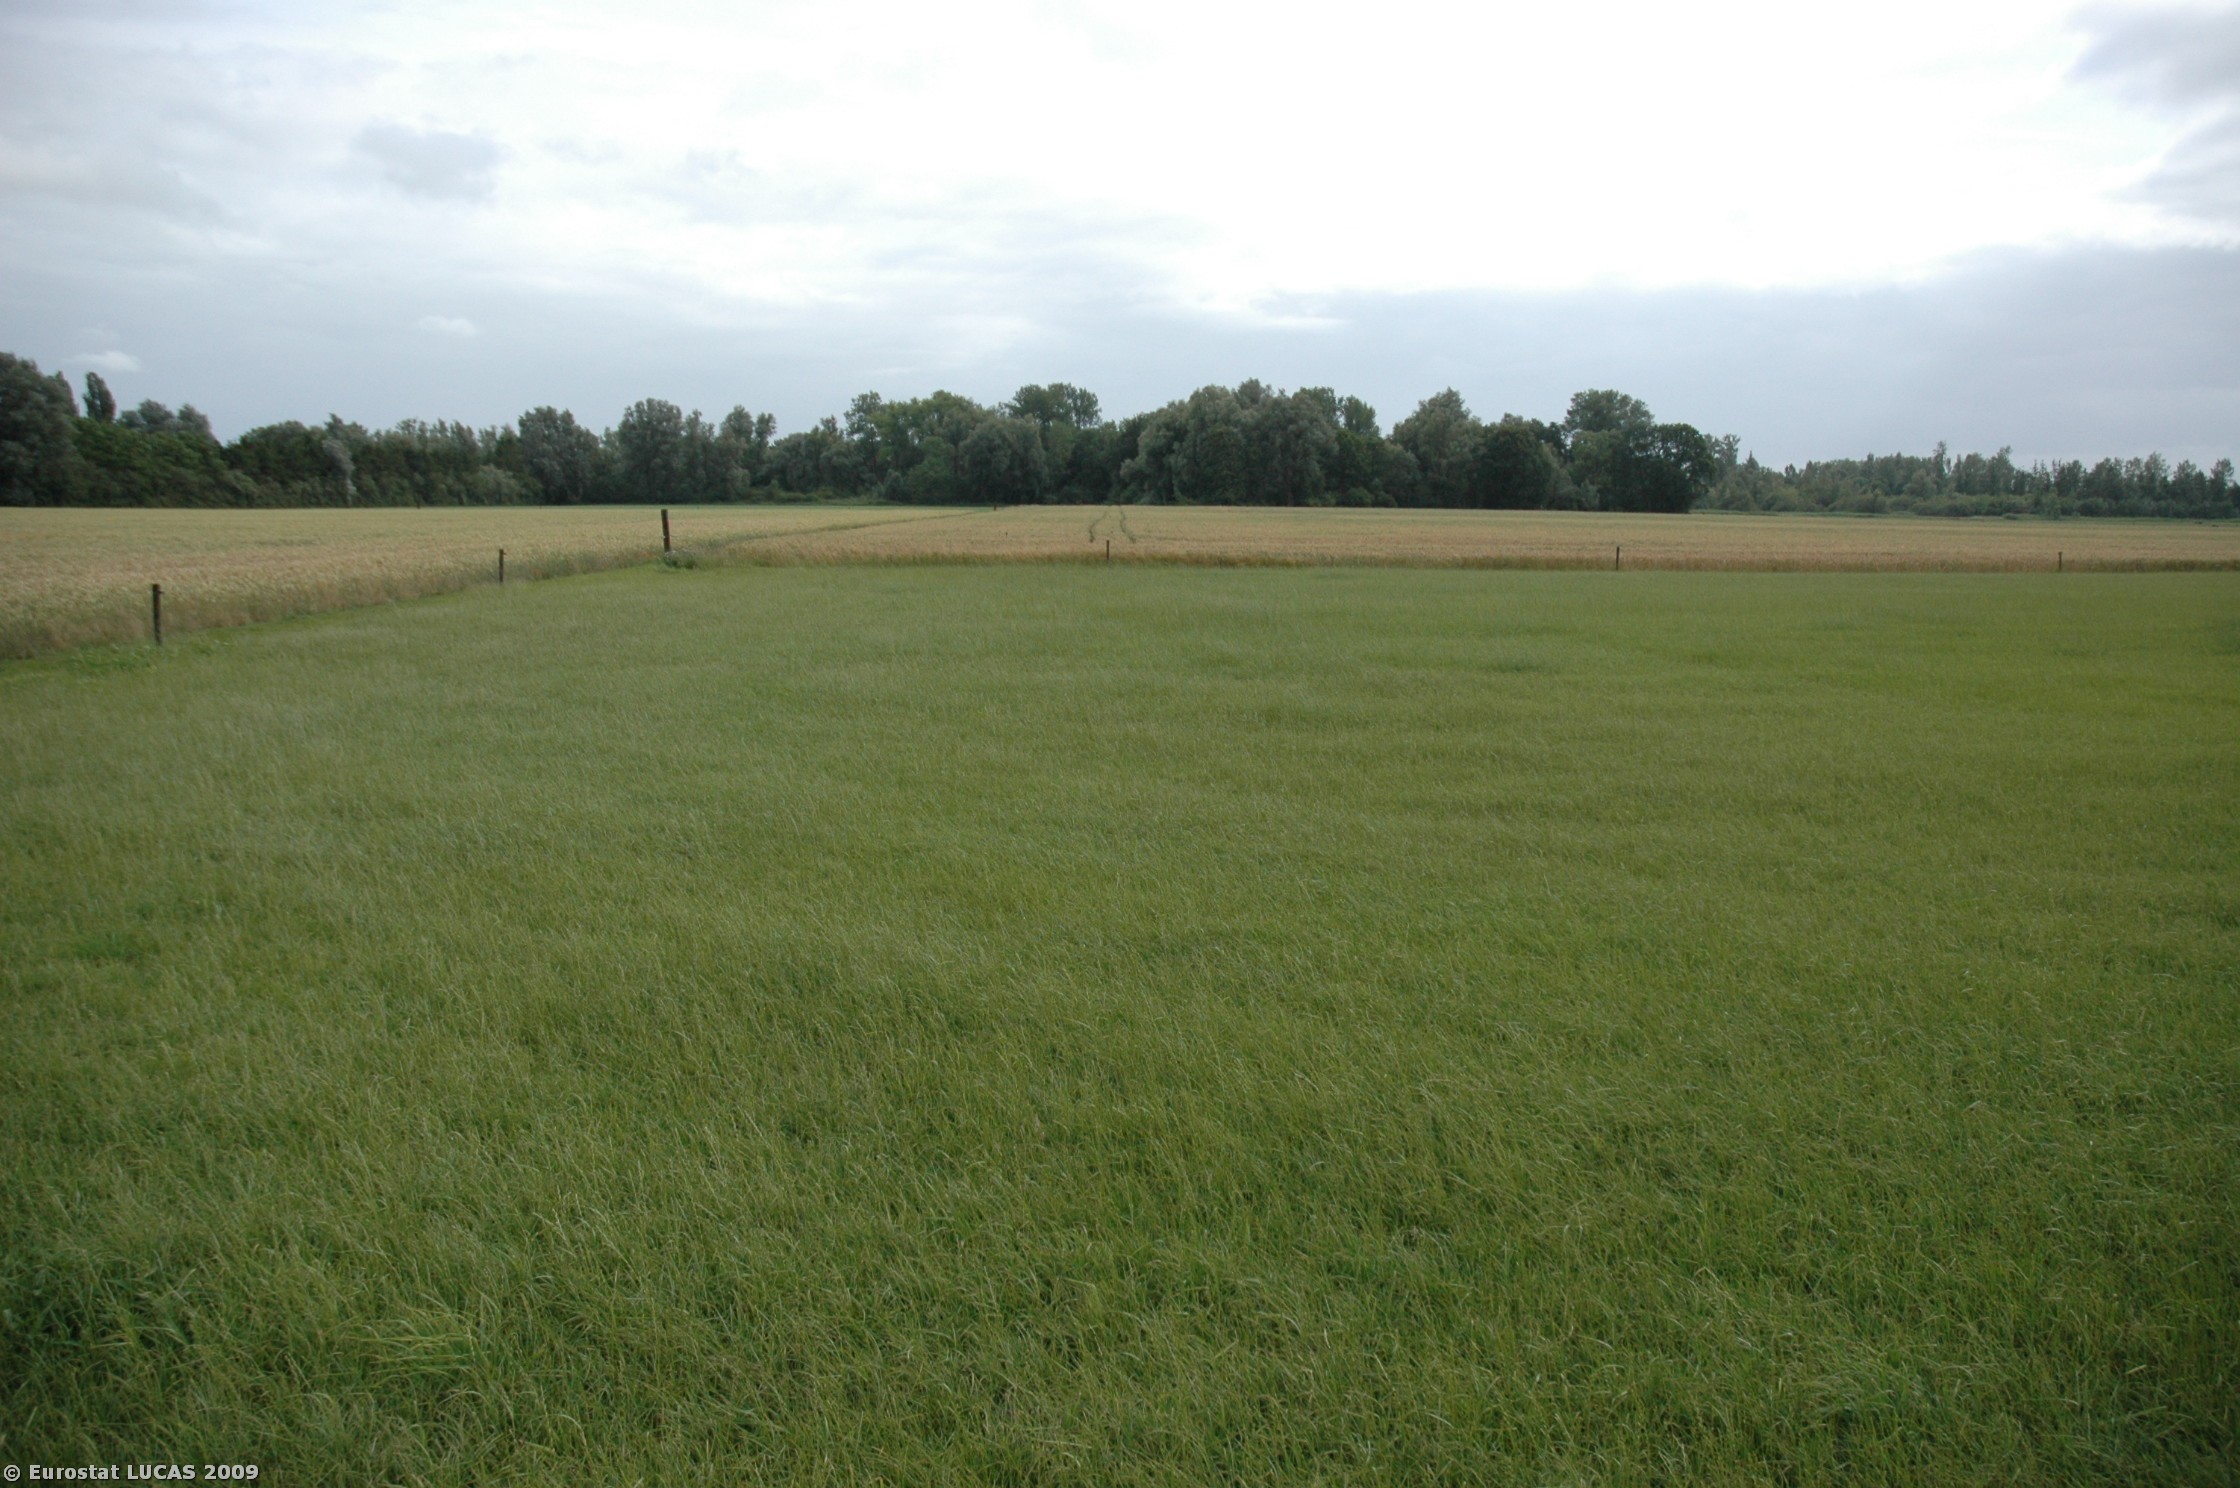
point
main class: Cropland
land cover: Common wheat
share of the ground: > 75 %
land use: Agriculture (excluding fallow land and kitchen gardens)
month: July
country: NL
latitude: 52.2950
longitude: 6.0844
